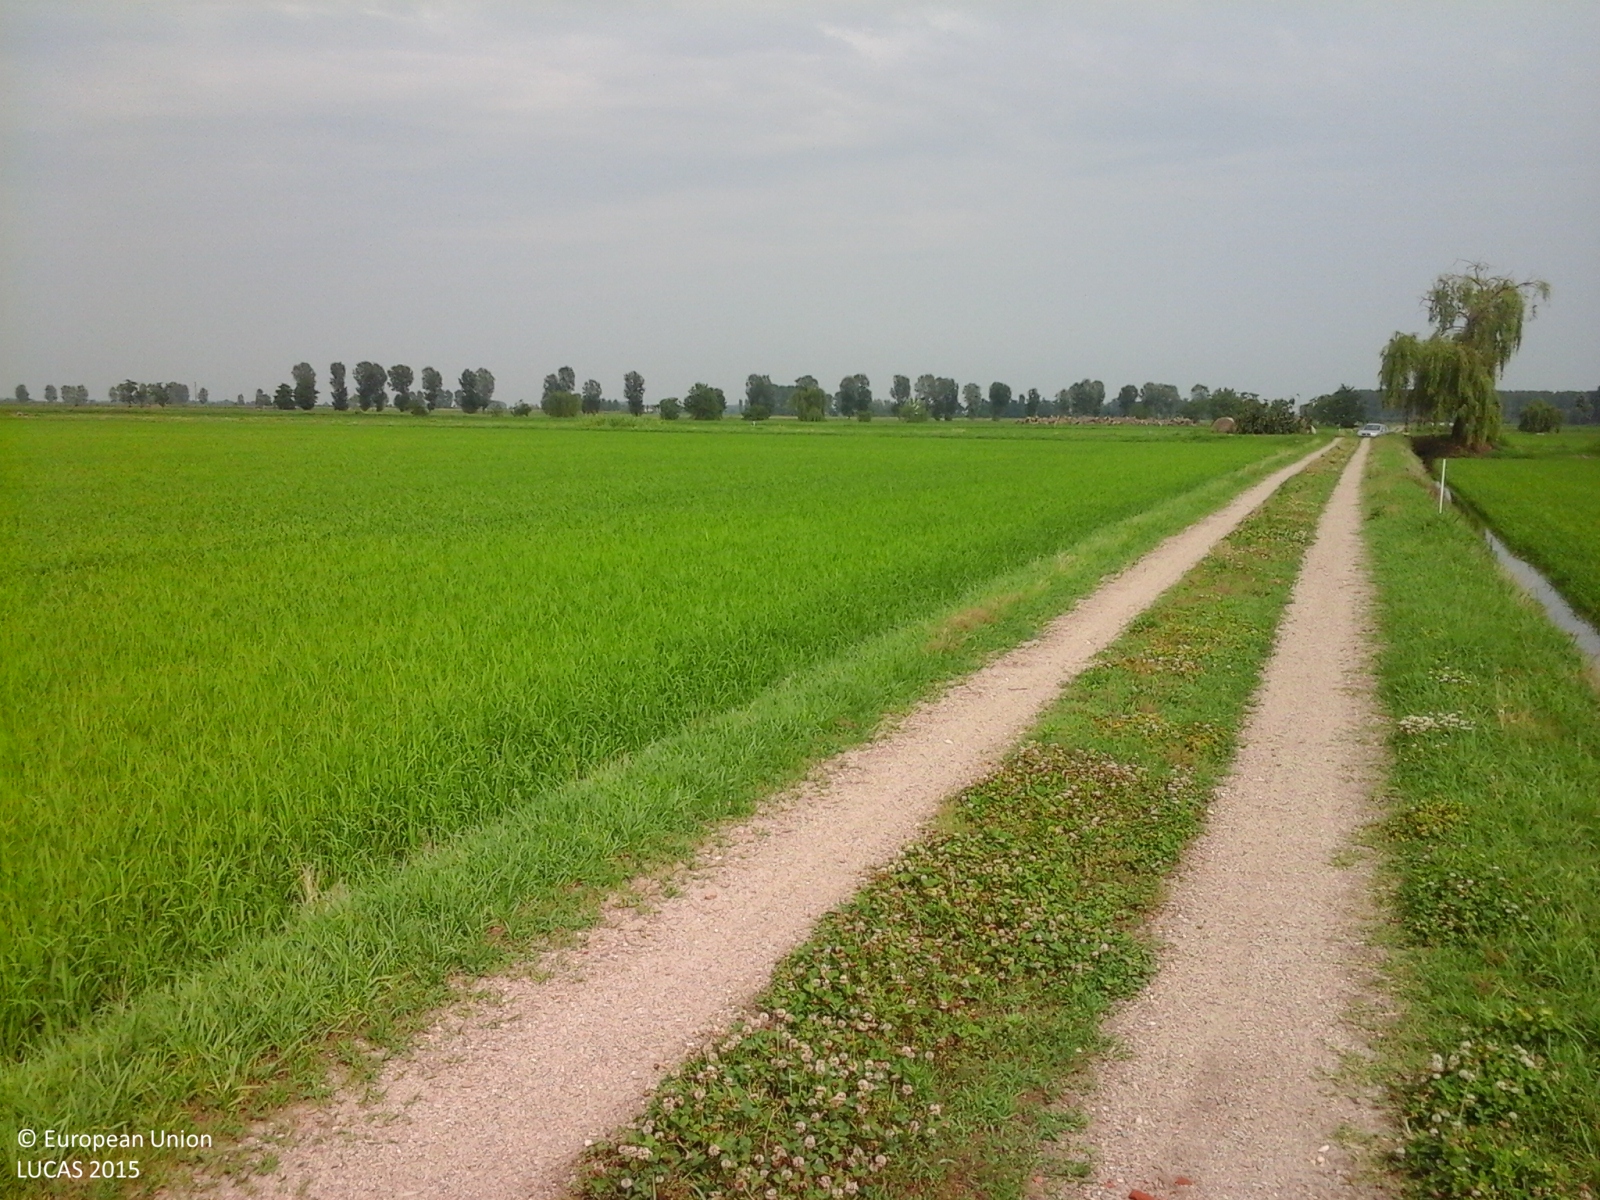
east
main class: Cropland
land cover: Rice
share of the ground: 50 - 75 %
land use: Agriculture (excluding fallow land and kitchen gardens)
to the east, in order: Rice; Grass margins; Tracks; Grass margins; Ditches and canals; Rice; Tracks; Inland fresh running water; Grass margins; Rice
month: June
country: IT
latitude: 45.3143
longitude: 8.5611
